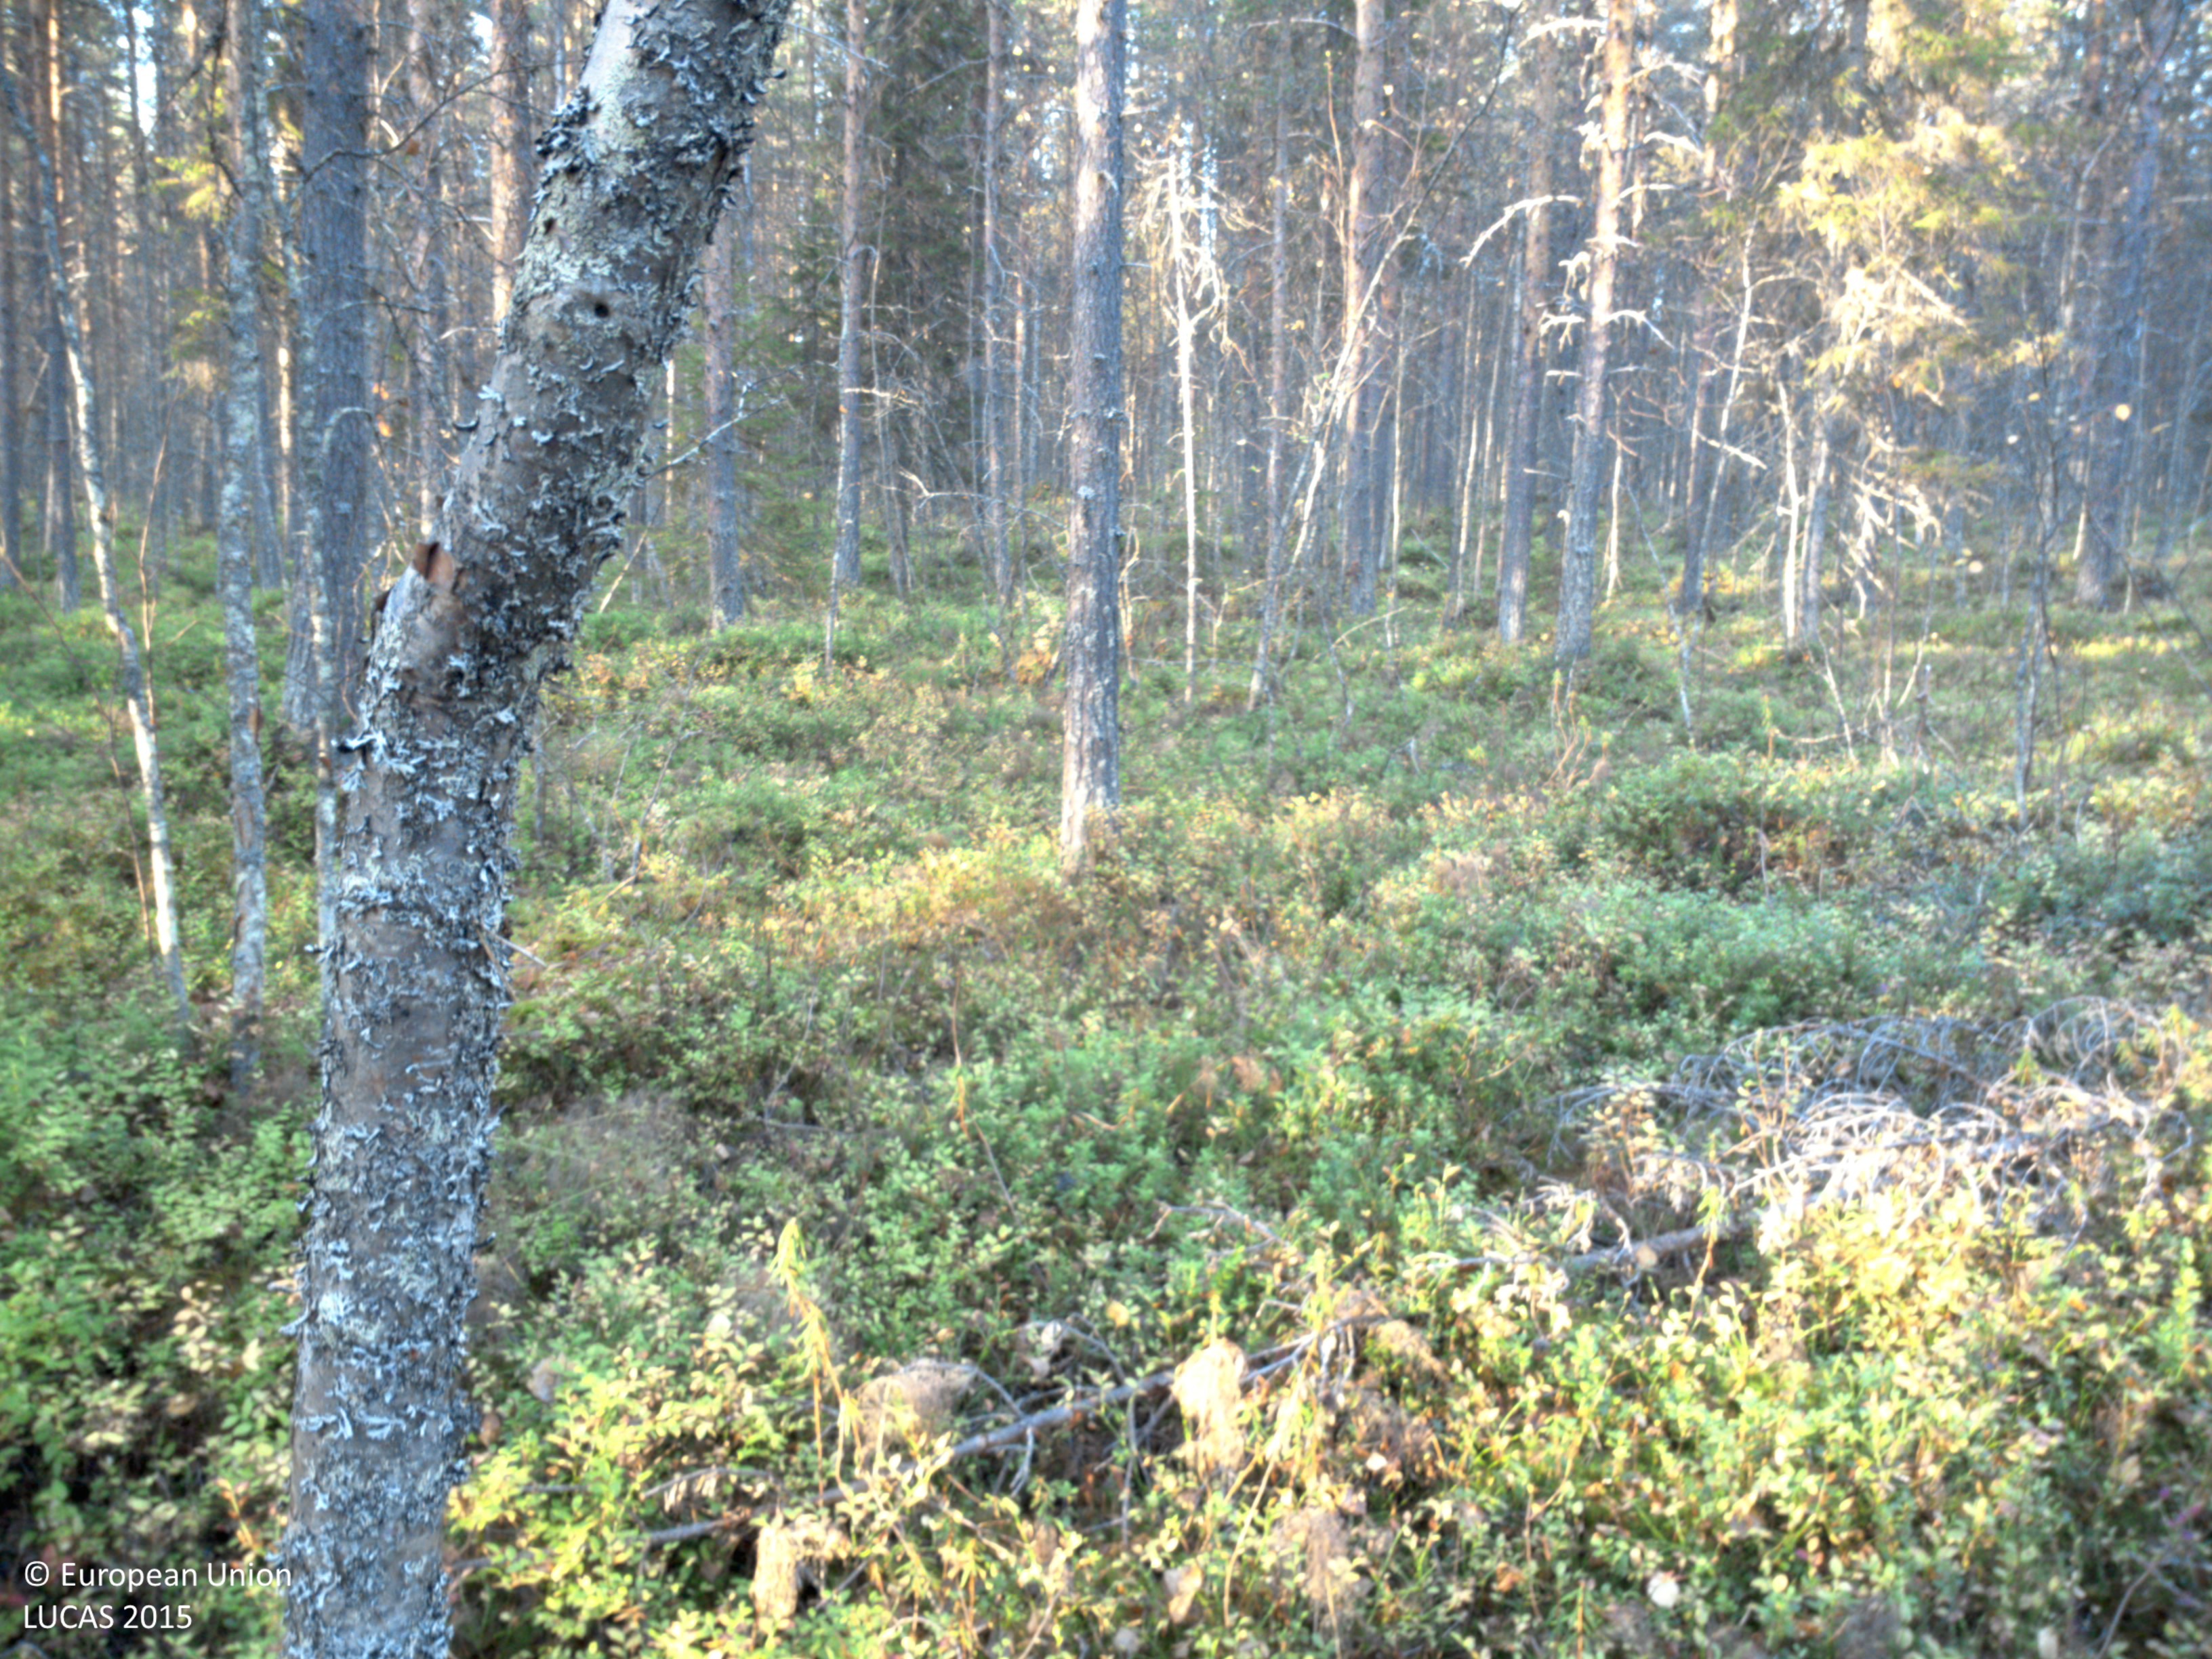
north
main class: Woodland
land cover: Pine dominated mixed woodland
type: boreal forest
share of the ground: 50 - 75 %
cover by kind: coniferous forest trees 45 %, shrubs 40 %, broadleaved forest trees 15 %
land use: Forestry
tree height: > 5 m
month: September
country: SE
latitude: 64.9430
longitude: 18.3233
